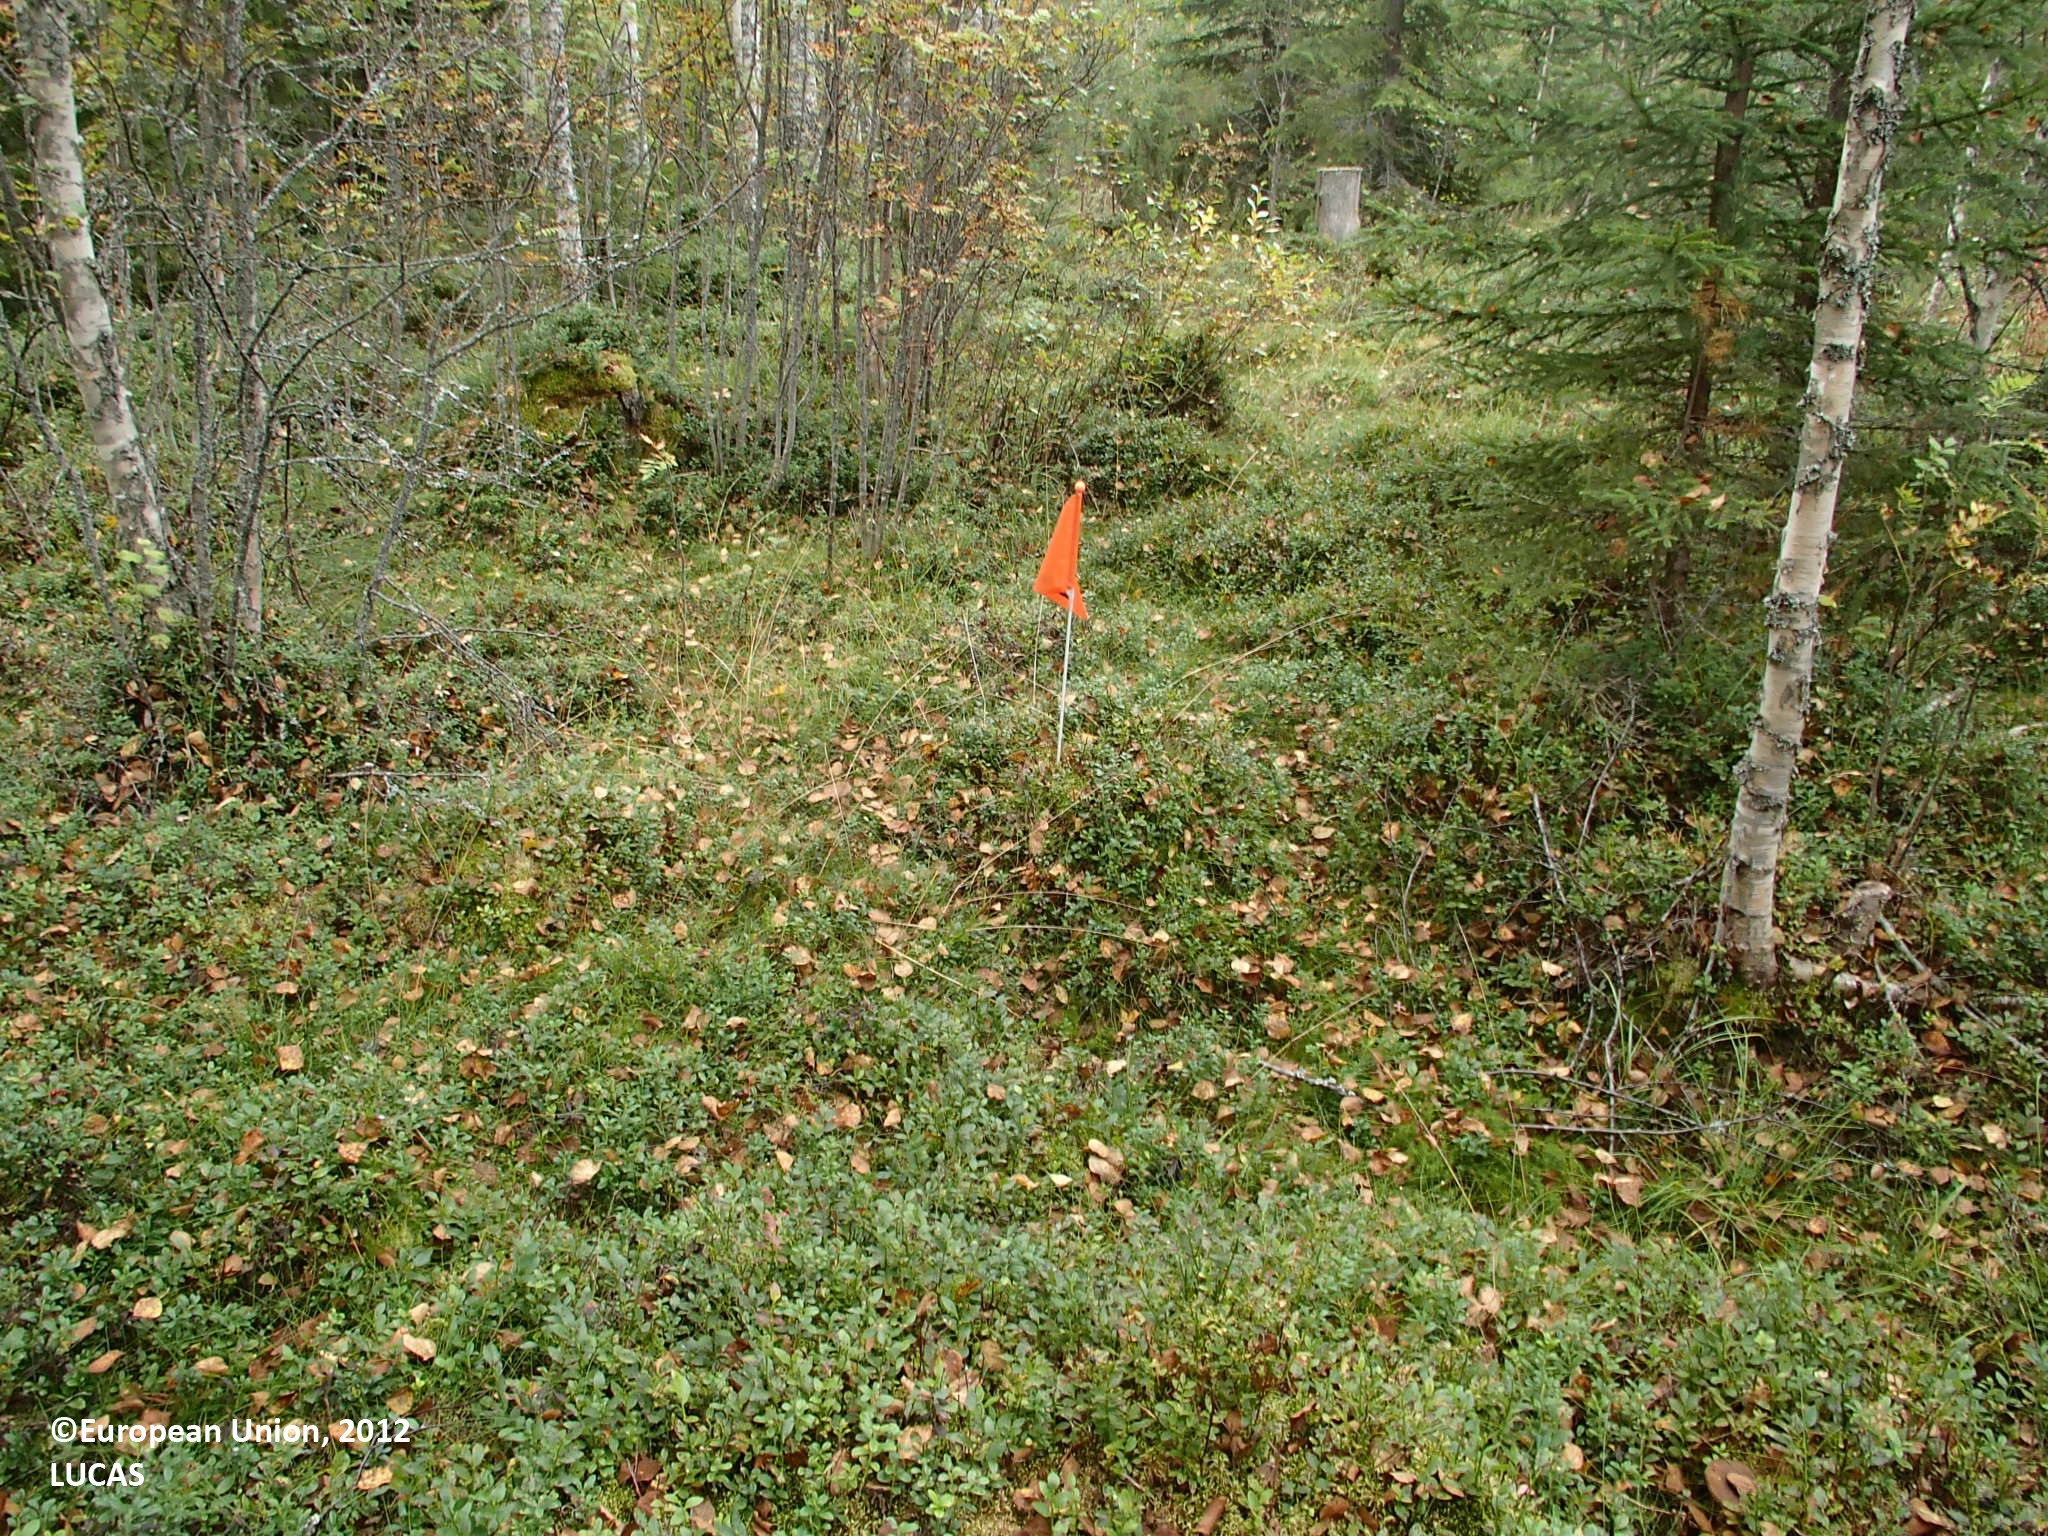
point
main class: Woodland
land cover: Other mixed woodland
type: boreal forest
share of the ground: > 75 %
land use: Forestry
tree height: > 5 m
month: September
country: FI
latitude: 63.8214
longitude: 25.9763
